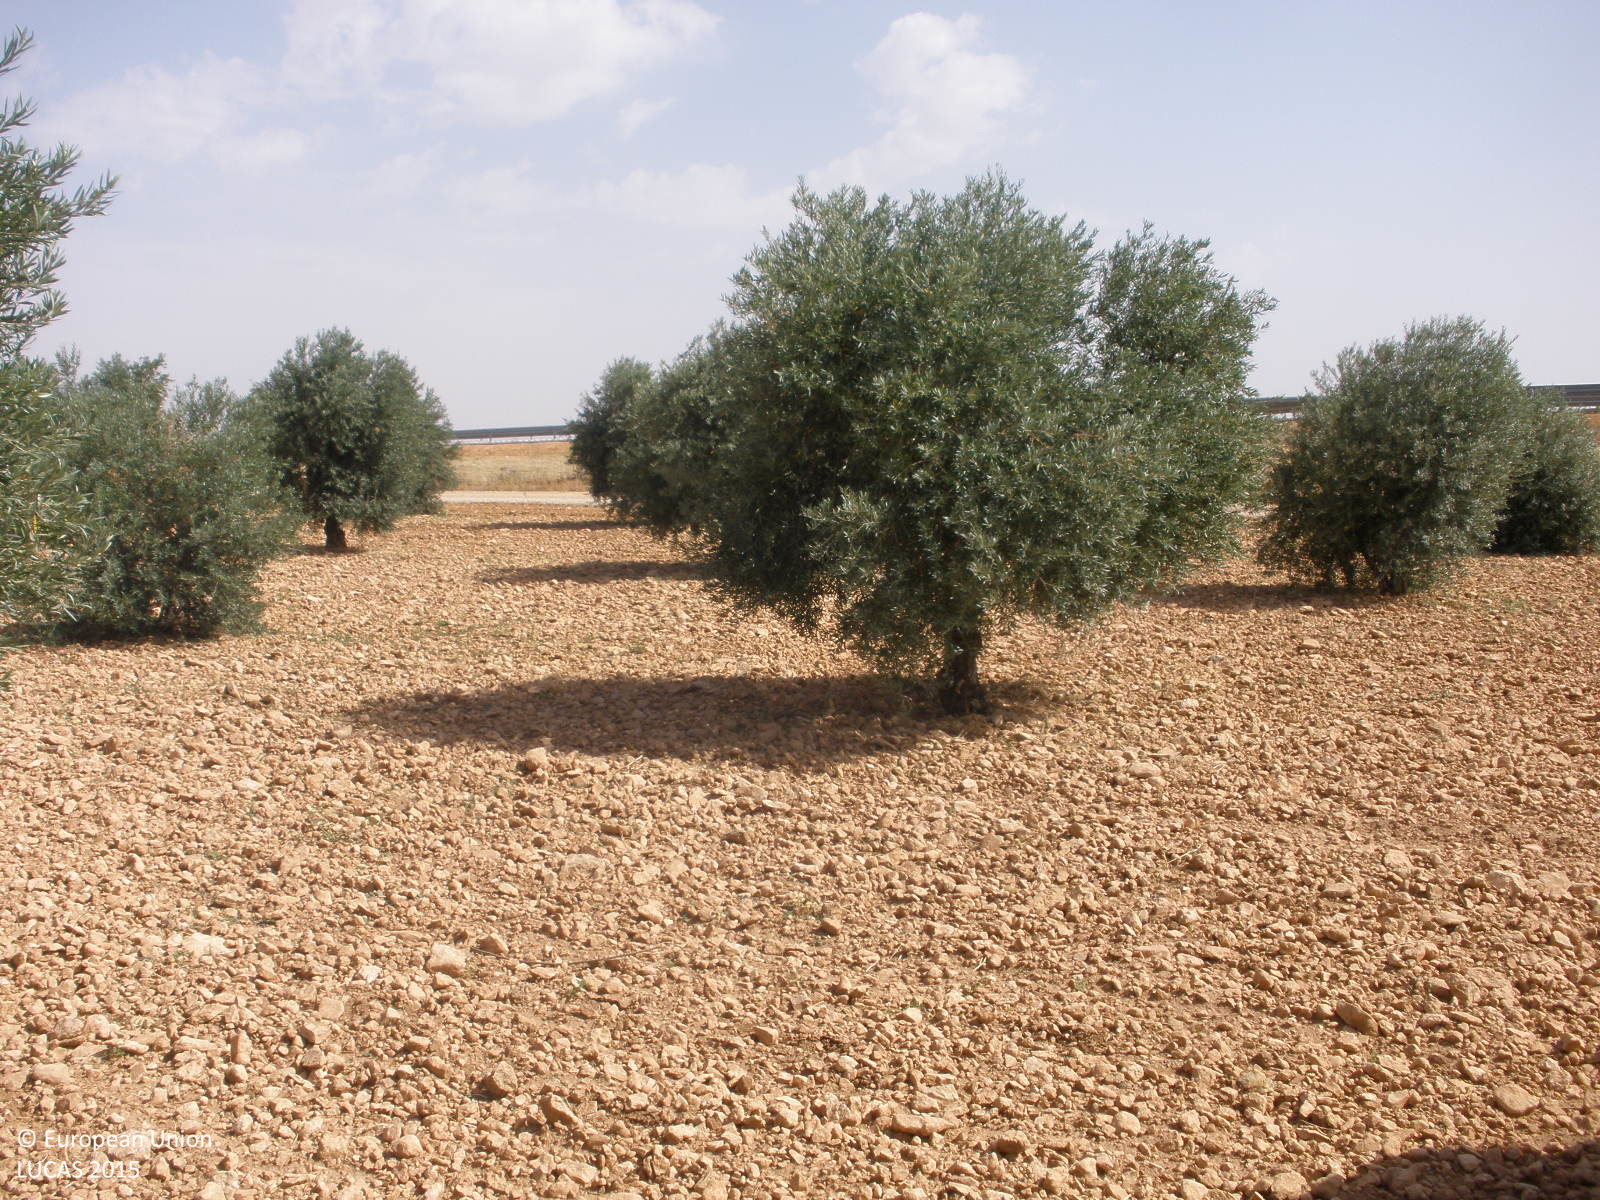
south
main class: Cropland
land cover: Olive groves
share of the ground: 25 - 50 %
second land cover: Other bare soil
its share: > 75 %
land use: Agriculture (excluding fallow land and kitchen gardens)
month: July
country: ES
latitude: 39.9293
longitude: -3.4018
